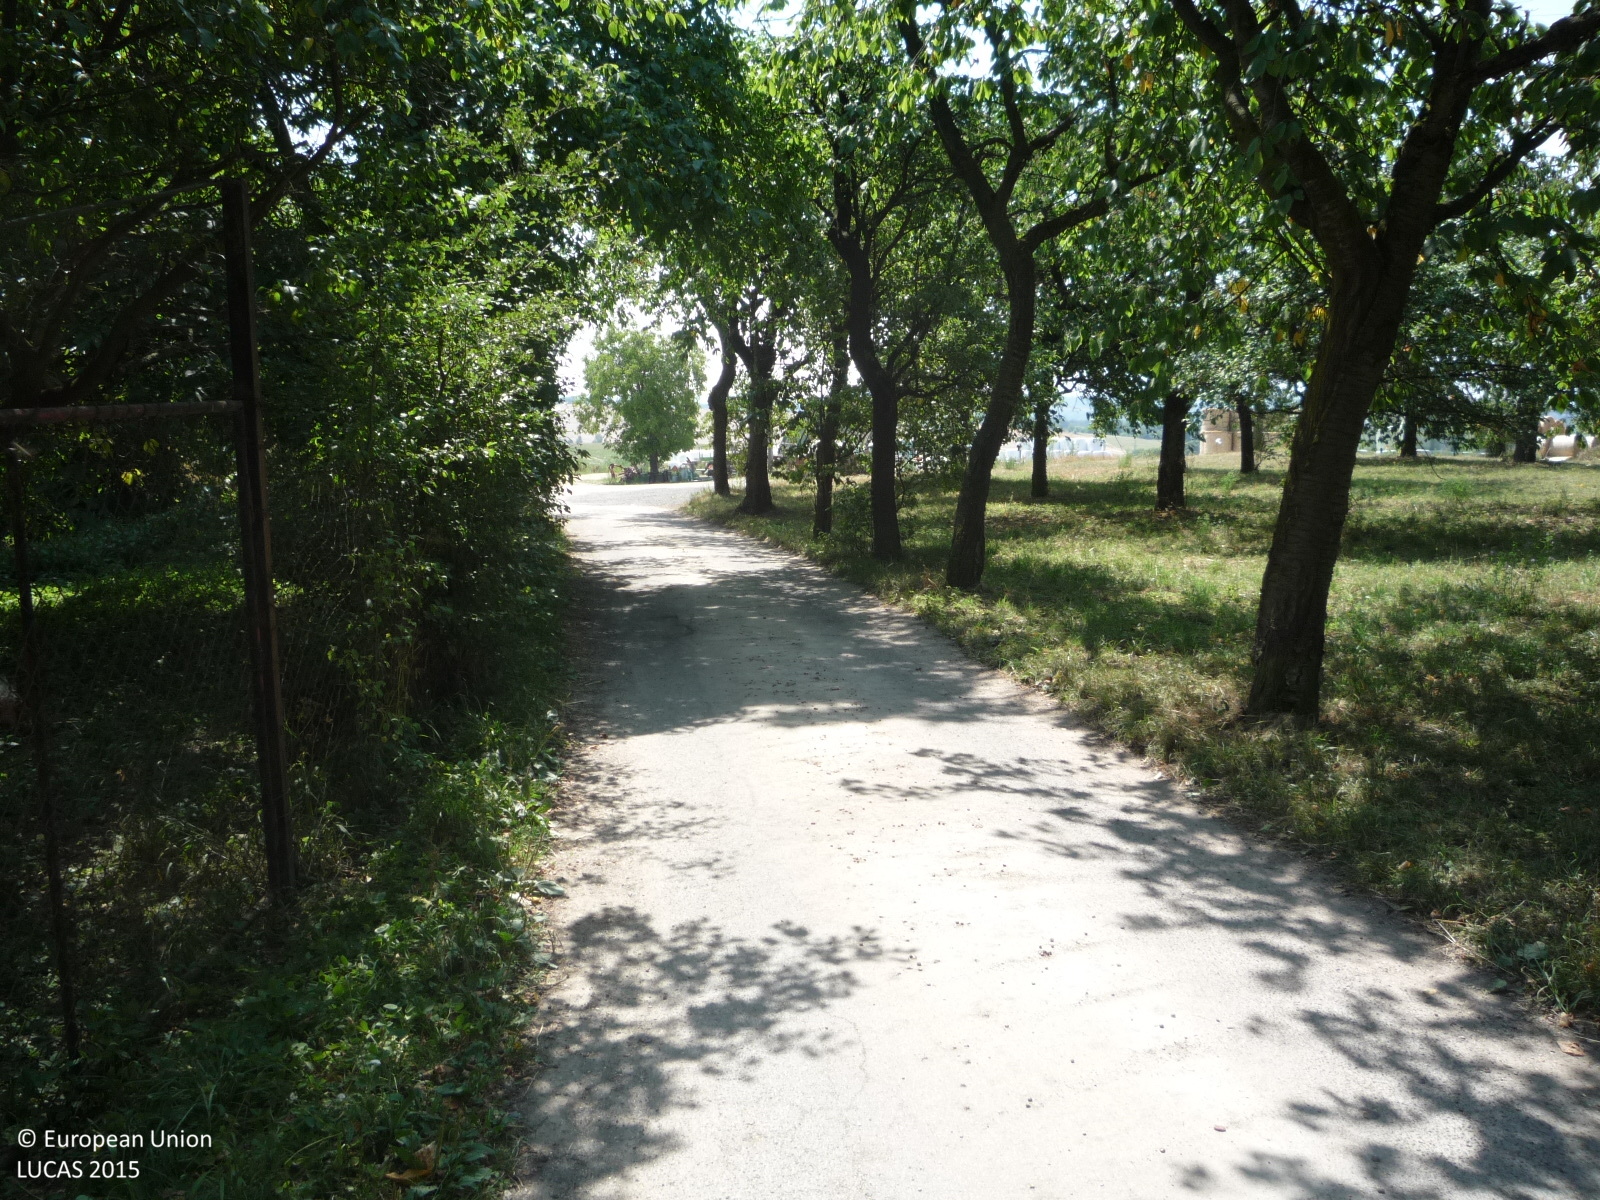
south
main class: Cropland
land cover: Apple fruit
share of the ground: > 75 %
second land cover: Grassland without tree/shrub cover
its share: 10 - 25 %
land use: Kitchen garden
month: August
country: CZ
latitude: 50.5683
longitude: 15.2415
